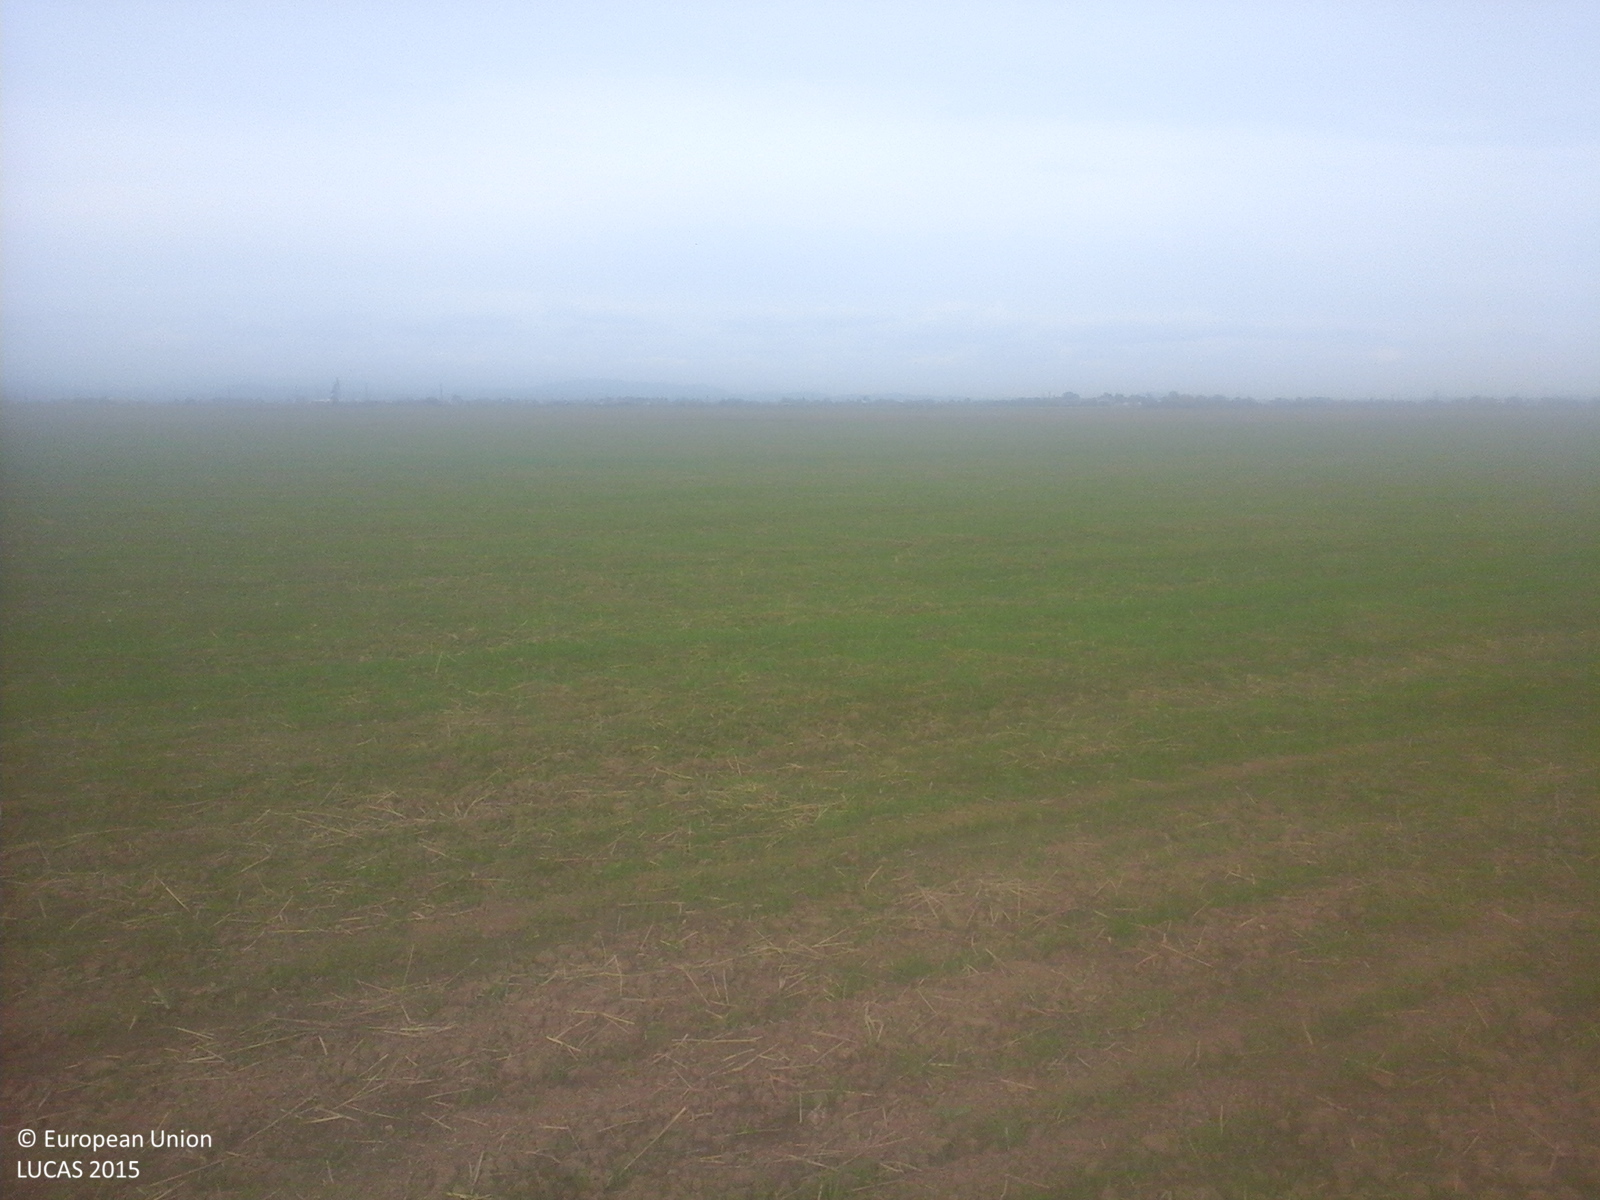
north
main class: Cropland
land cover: Common wheat
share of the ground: 10 - 25 %
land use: Agriculture (excluding fallow land and kitchen gardens)
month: October
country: RO
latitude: 44.9502
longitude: 25.7814
